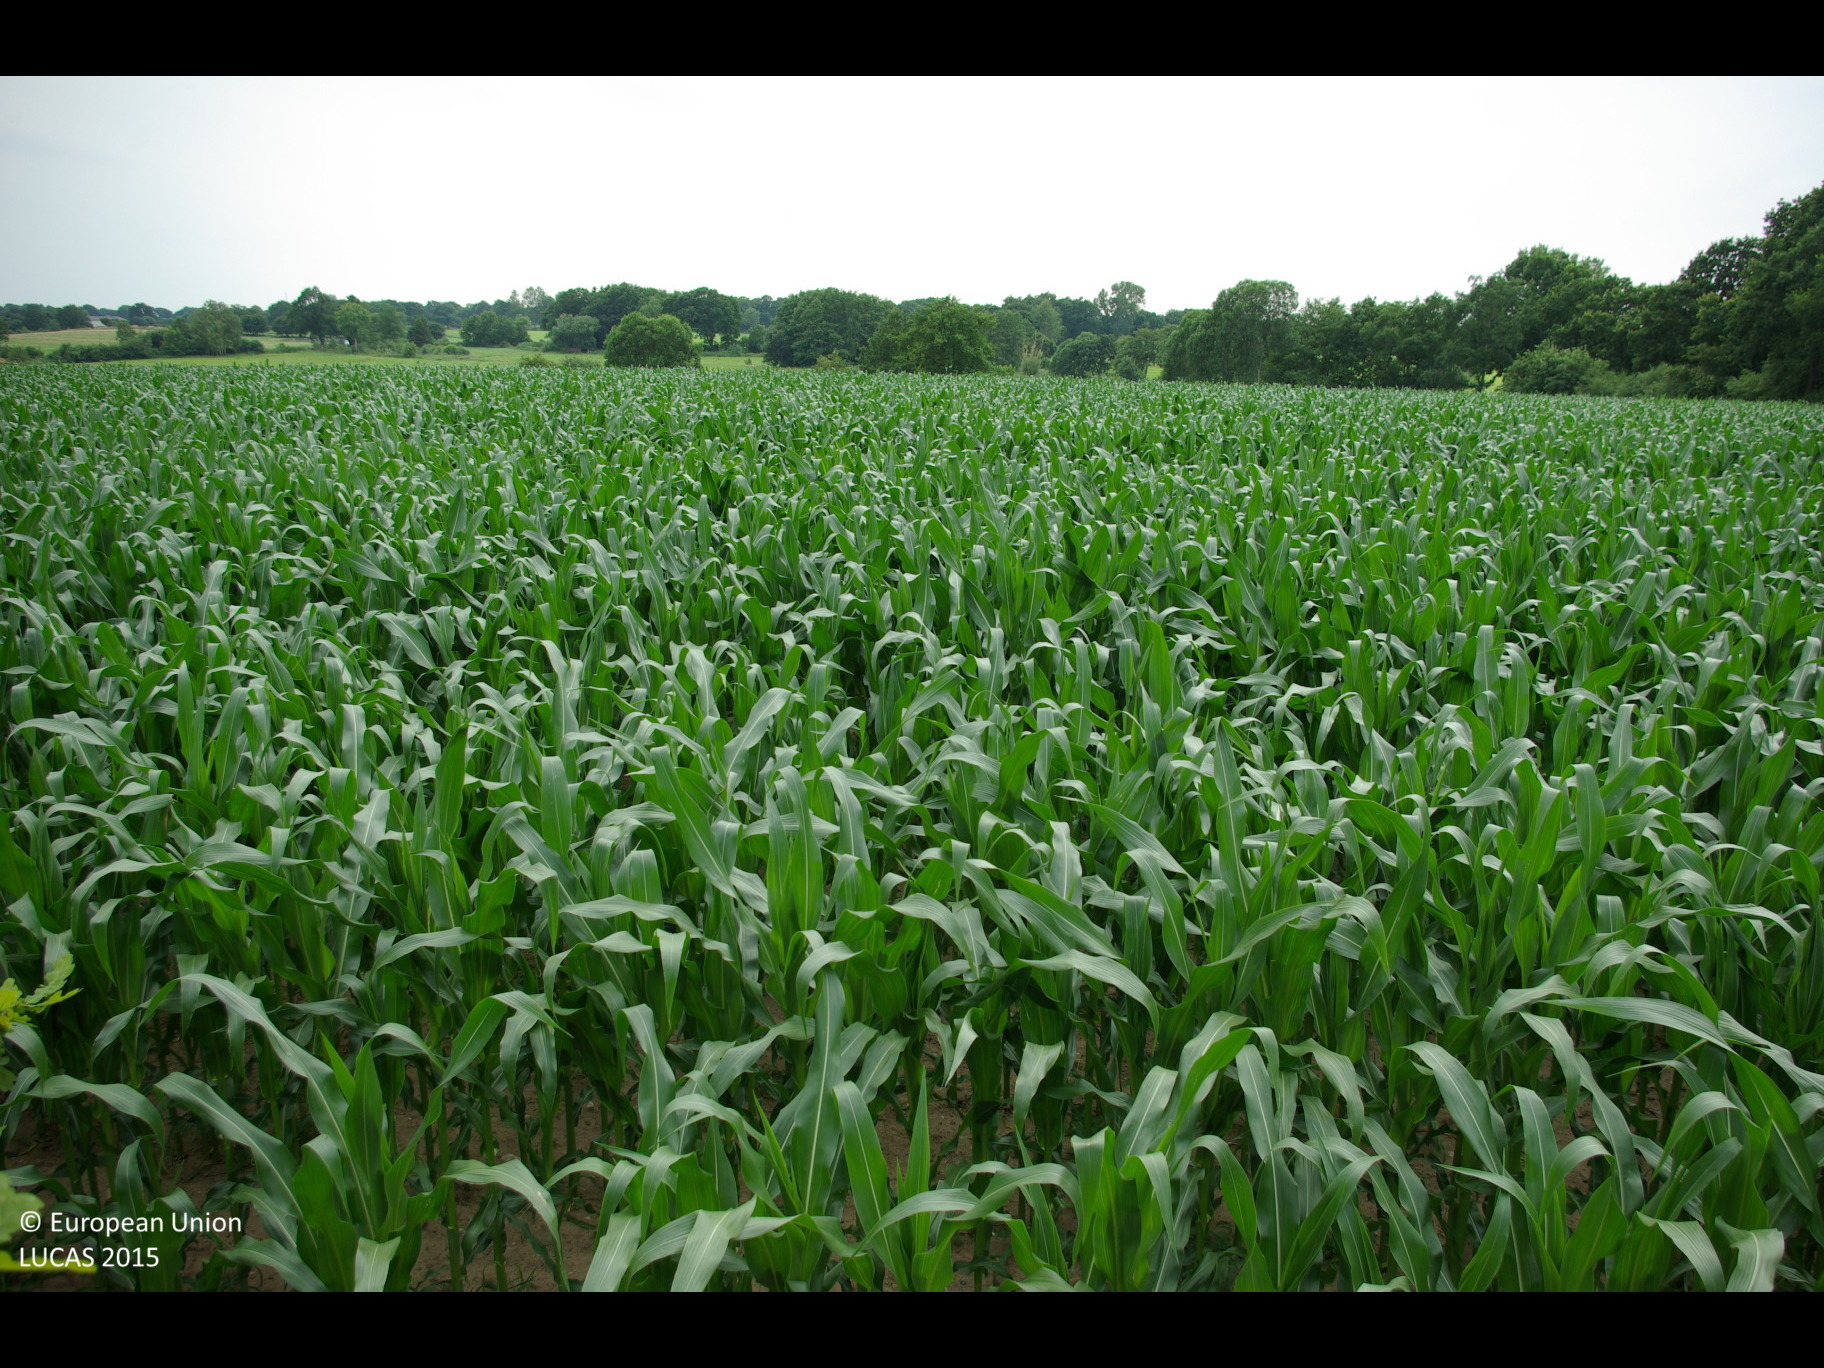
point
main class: Cropland
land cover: Maize
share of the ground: > 75 %
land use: Agriculture (excluding fallow land and kitchen gardens)
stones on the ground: 25 - 50 %
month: July
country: DE
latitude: 54.2267
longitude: 9.3102
